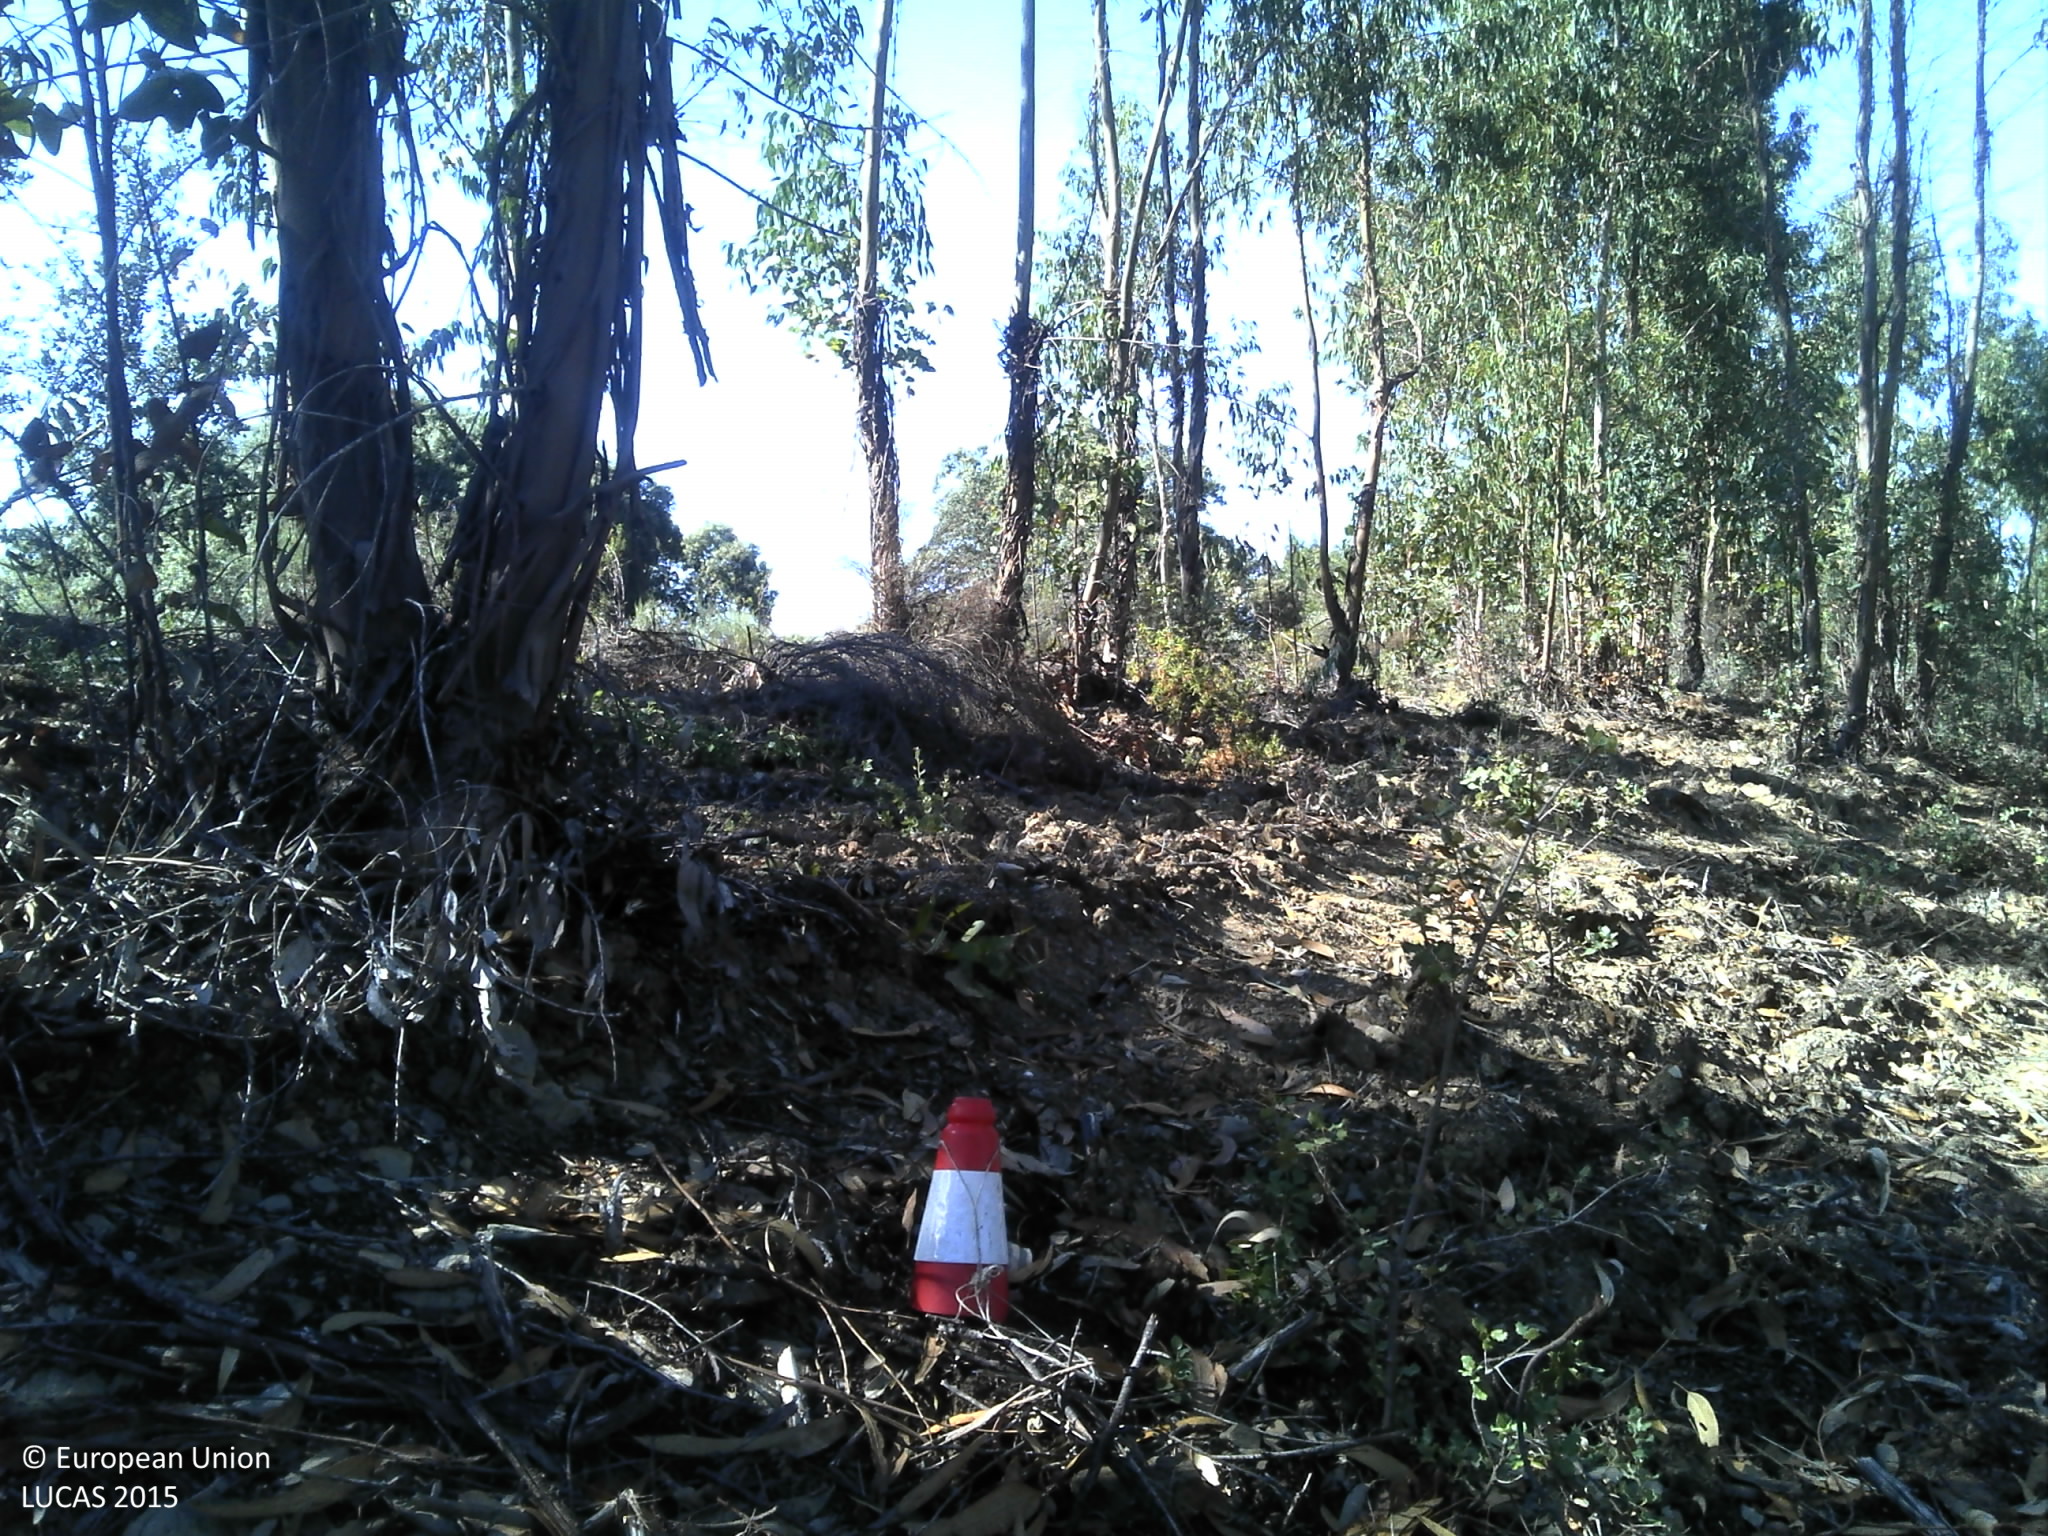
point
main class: Woodland
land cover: Broadleaved woodland
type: exotic forest
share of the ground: 50 - 75 %
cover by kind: broadleaved forest trees 75 %, unconsolidated bare surface 15 %, shrubs 5 %
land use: Forestry
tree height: > 5 m
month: June
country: PT
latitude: 40.0416
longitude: -7.2198
